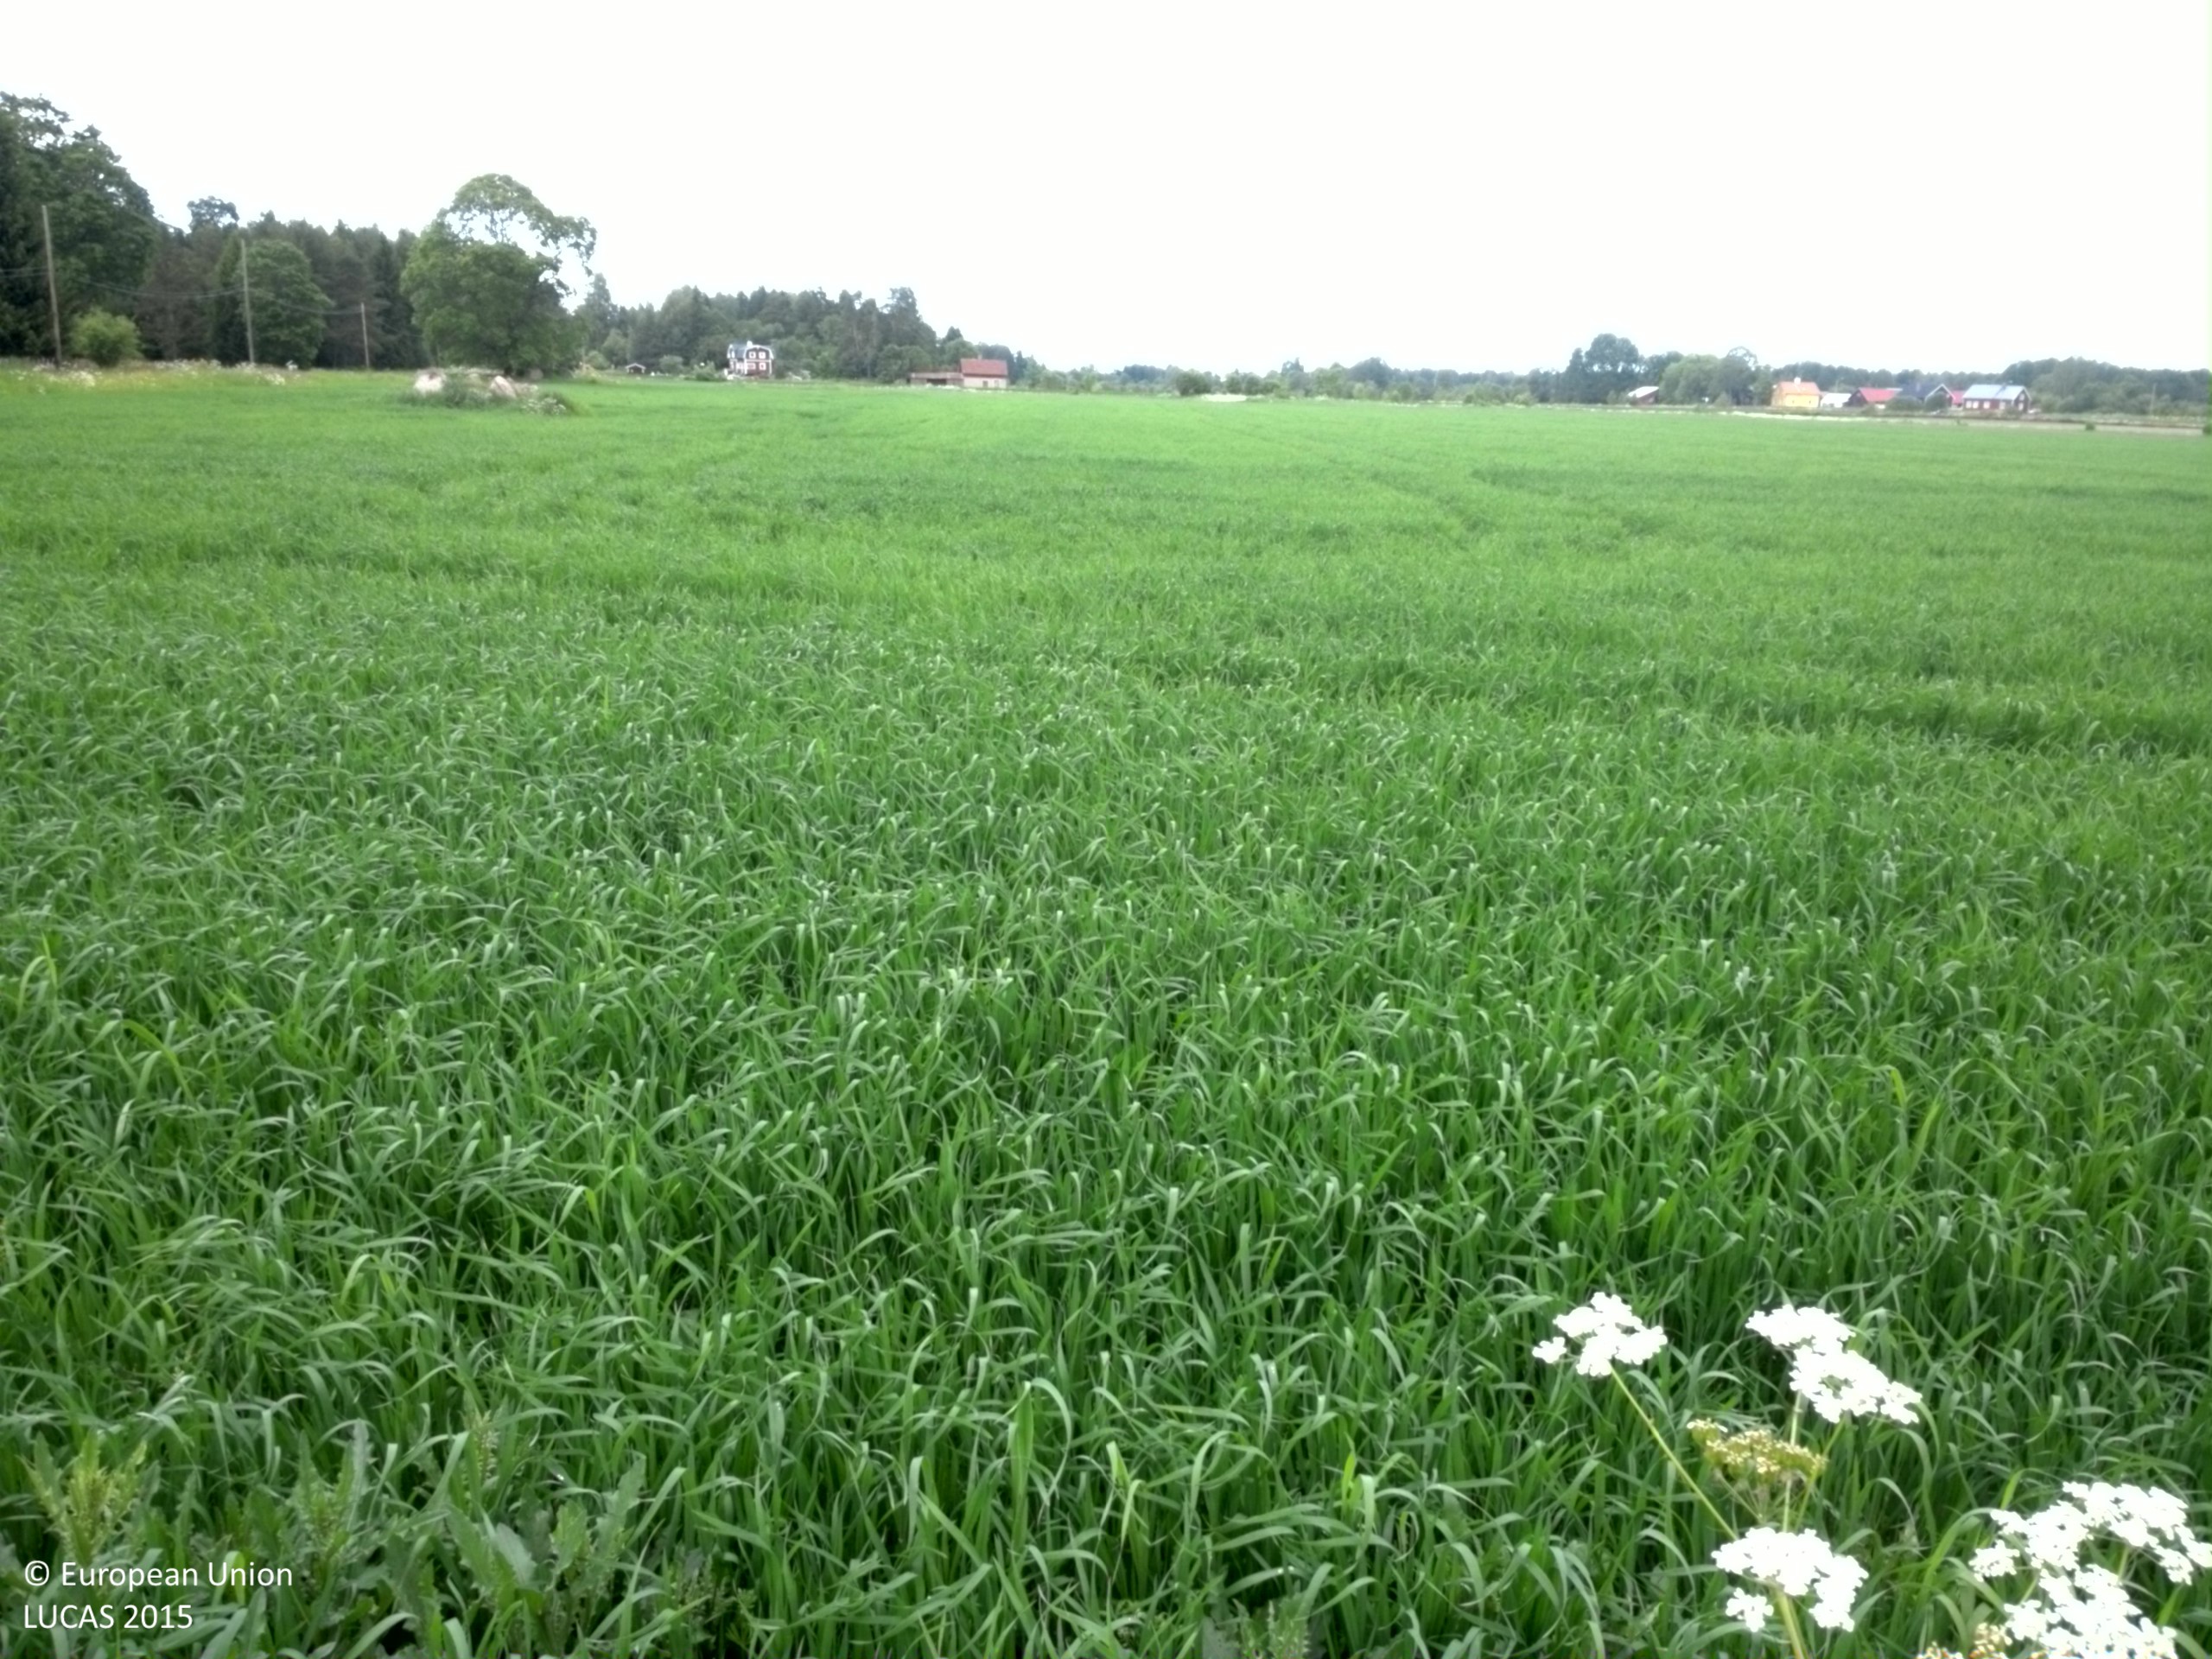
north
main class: Cropland
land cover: Common wheat
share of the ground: > 75 %
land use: Agriculture (excluding fallow land and kitchen gardens)
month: June
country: SE
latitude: 60.4279
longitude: 17.6028
